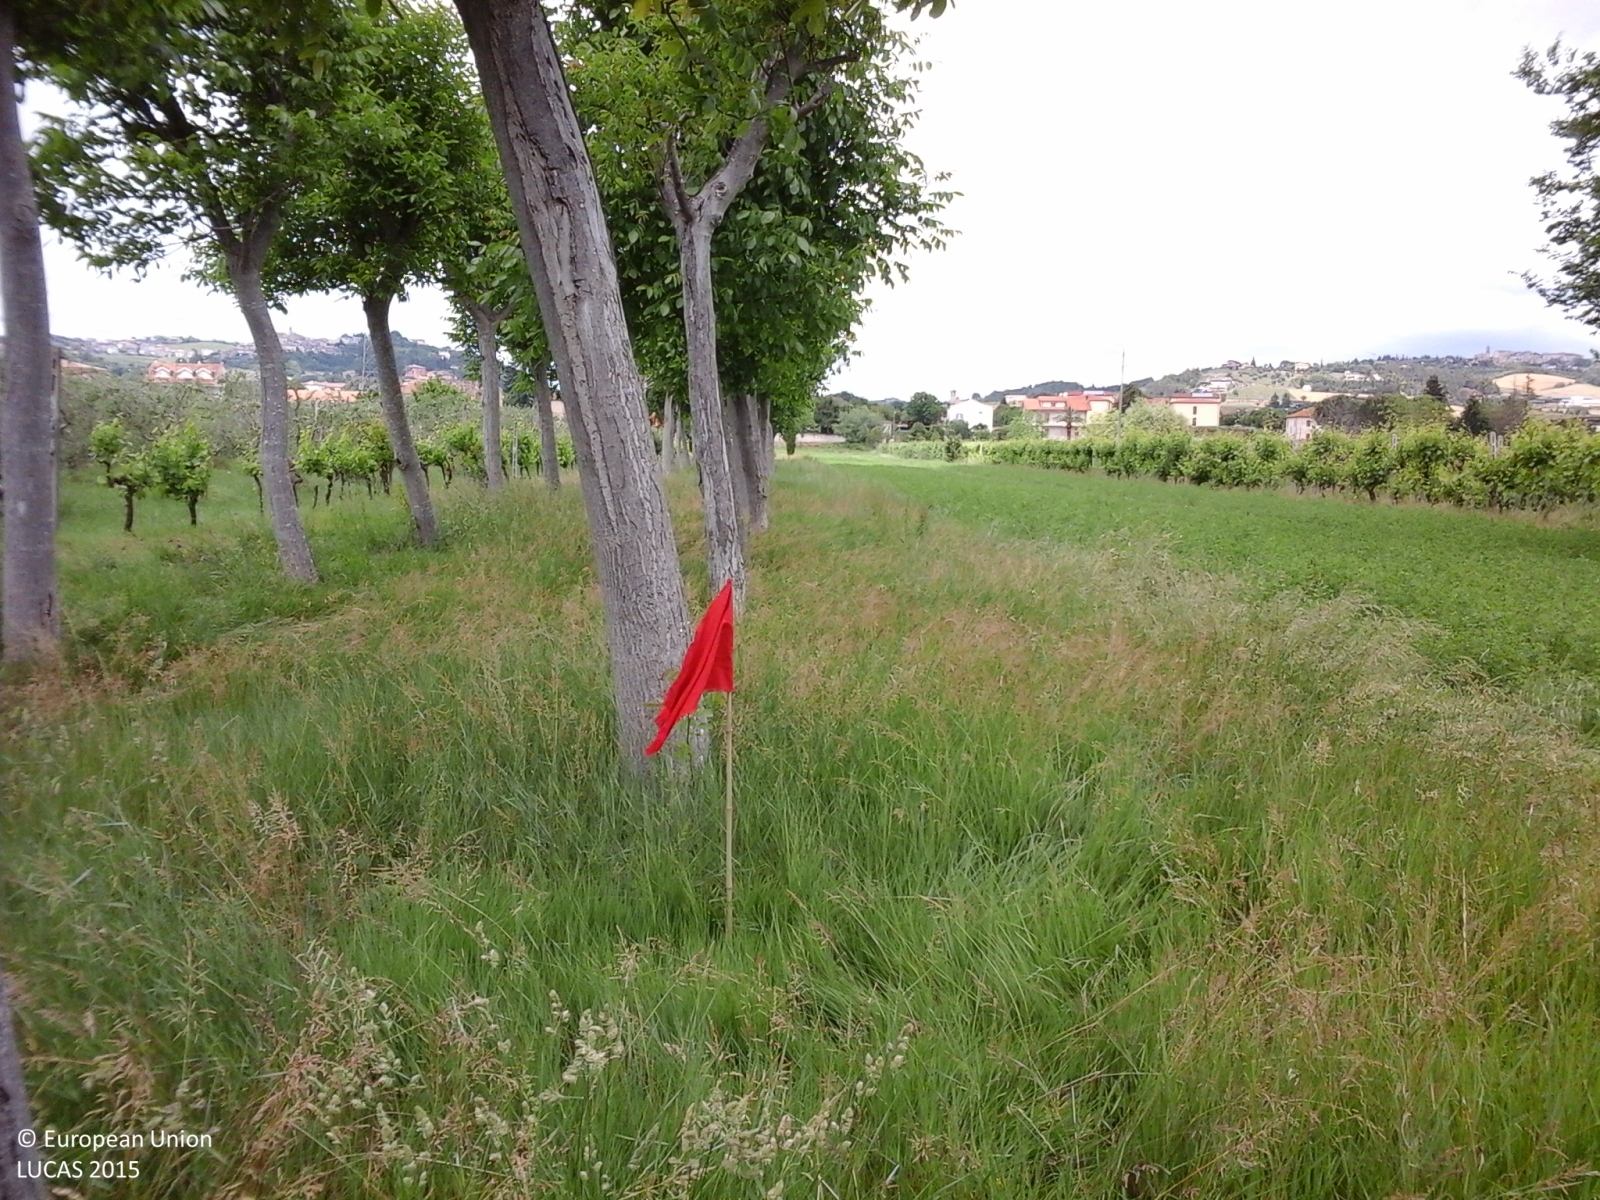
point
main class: Cropland
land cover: Nuts trees
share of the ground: > 75 %
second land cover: Grassland without tree/shrub cover
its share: > 75 %
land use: Agriculture (excluding fallow land and kitchen gardens)
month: May
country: IT
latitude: 42.8721
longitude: 13.7966
